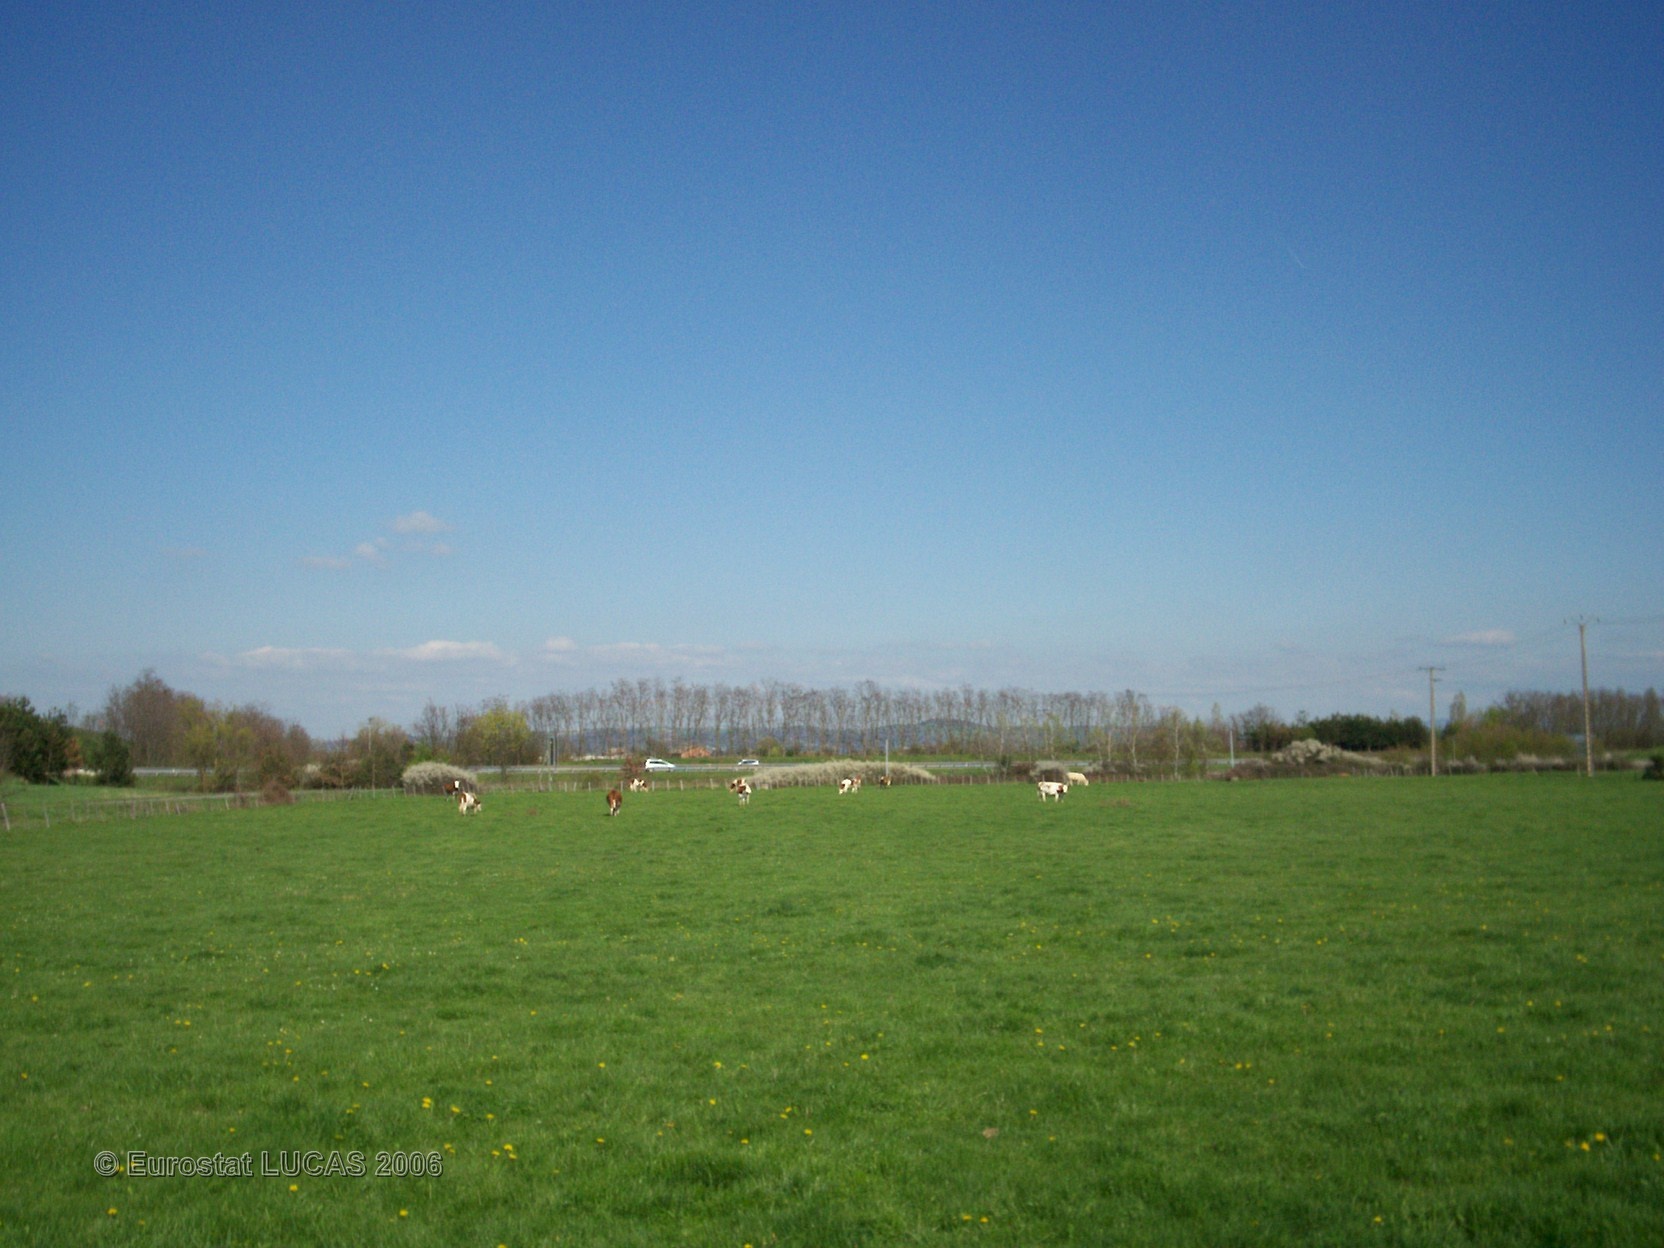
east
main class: Grassland
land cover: Grassland without tree/shrub cover
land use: Agriculture (excluding fallow land and kitchen gardens)
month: April
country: FR
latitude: 45.6335
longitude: 4.1919
